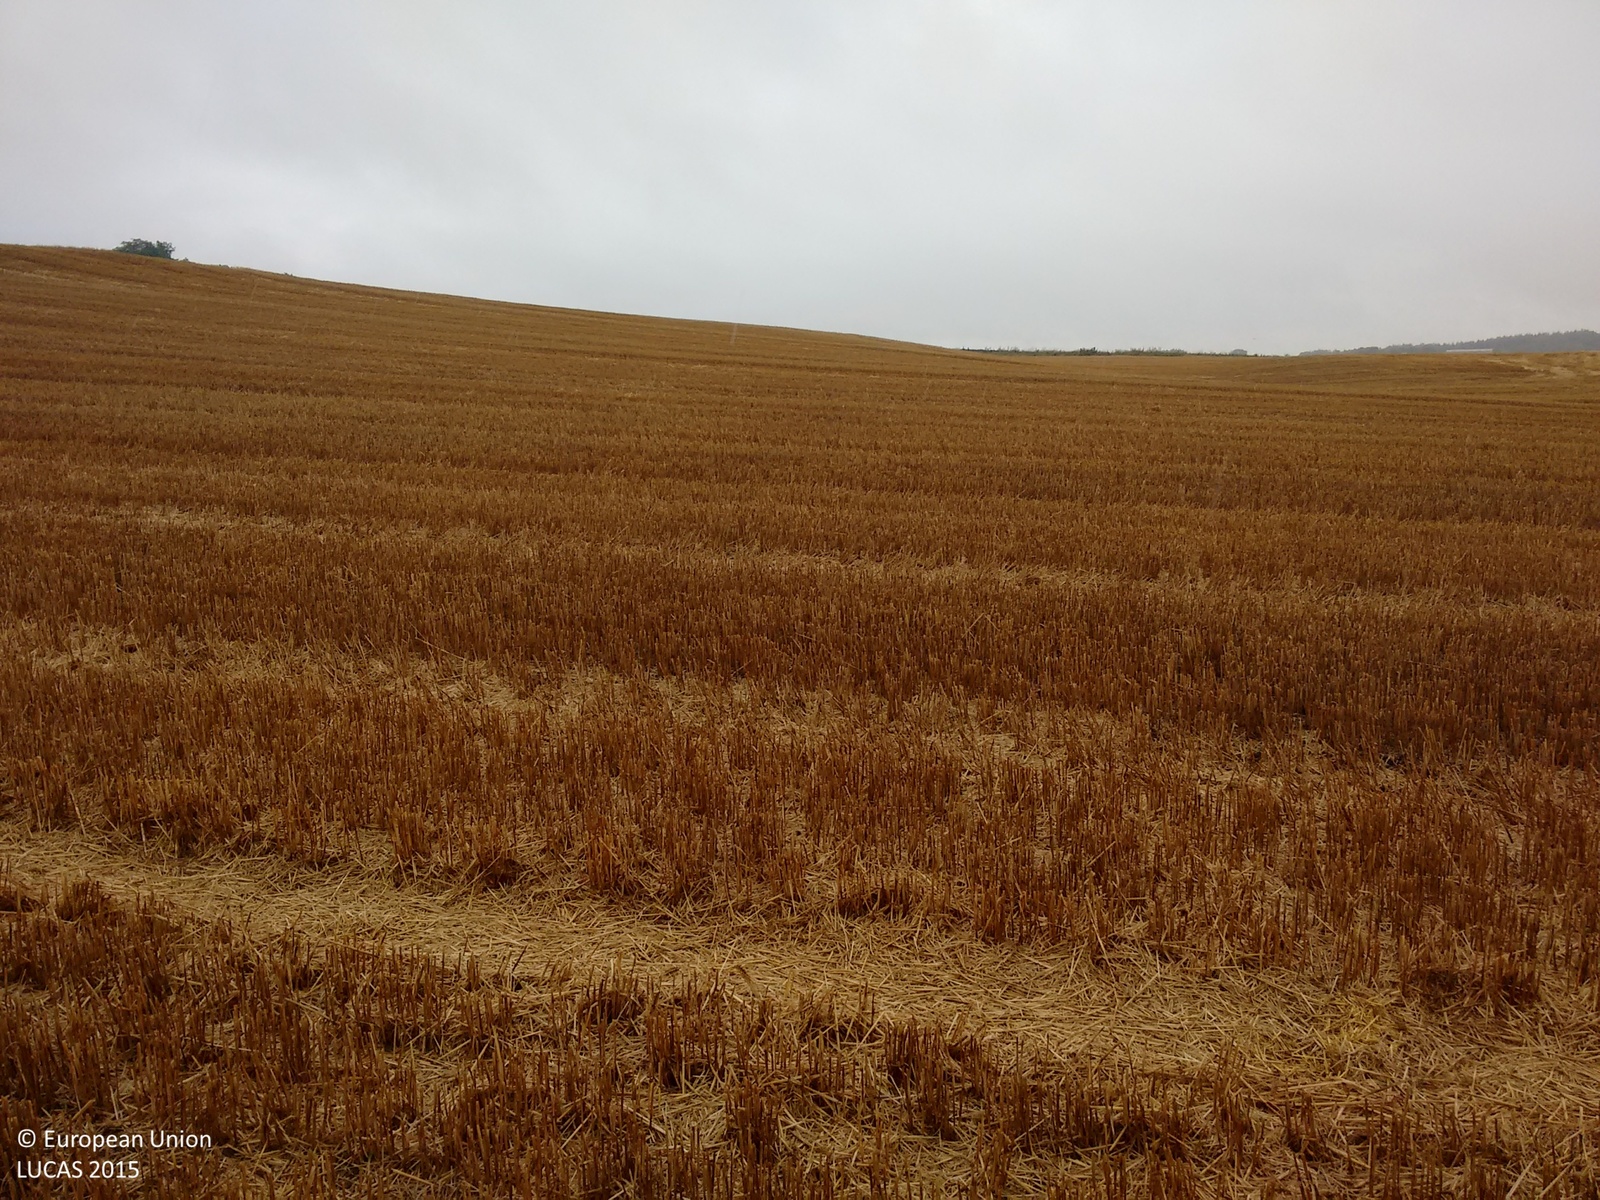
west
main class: Cropland
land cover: Barley
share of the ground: > 75 %
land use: Agriculture (excluding fallow land and kitchen gardens)
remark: Harvested field
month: August
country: GB
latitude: 57.3900
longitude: -2.1767
